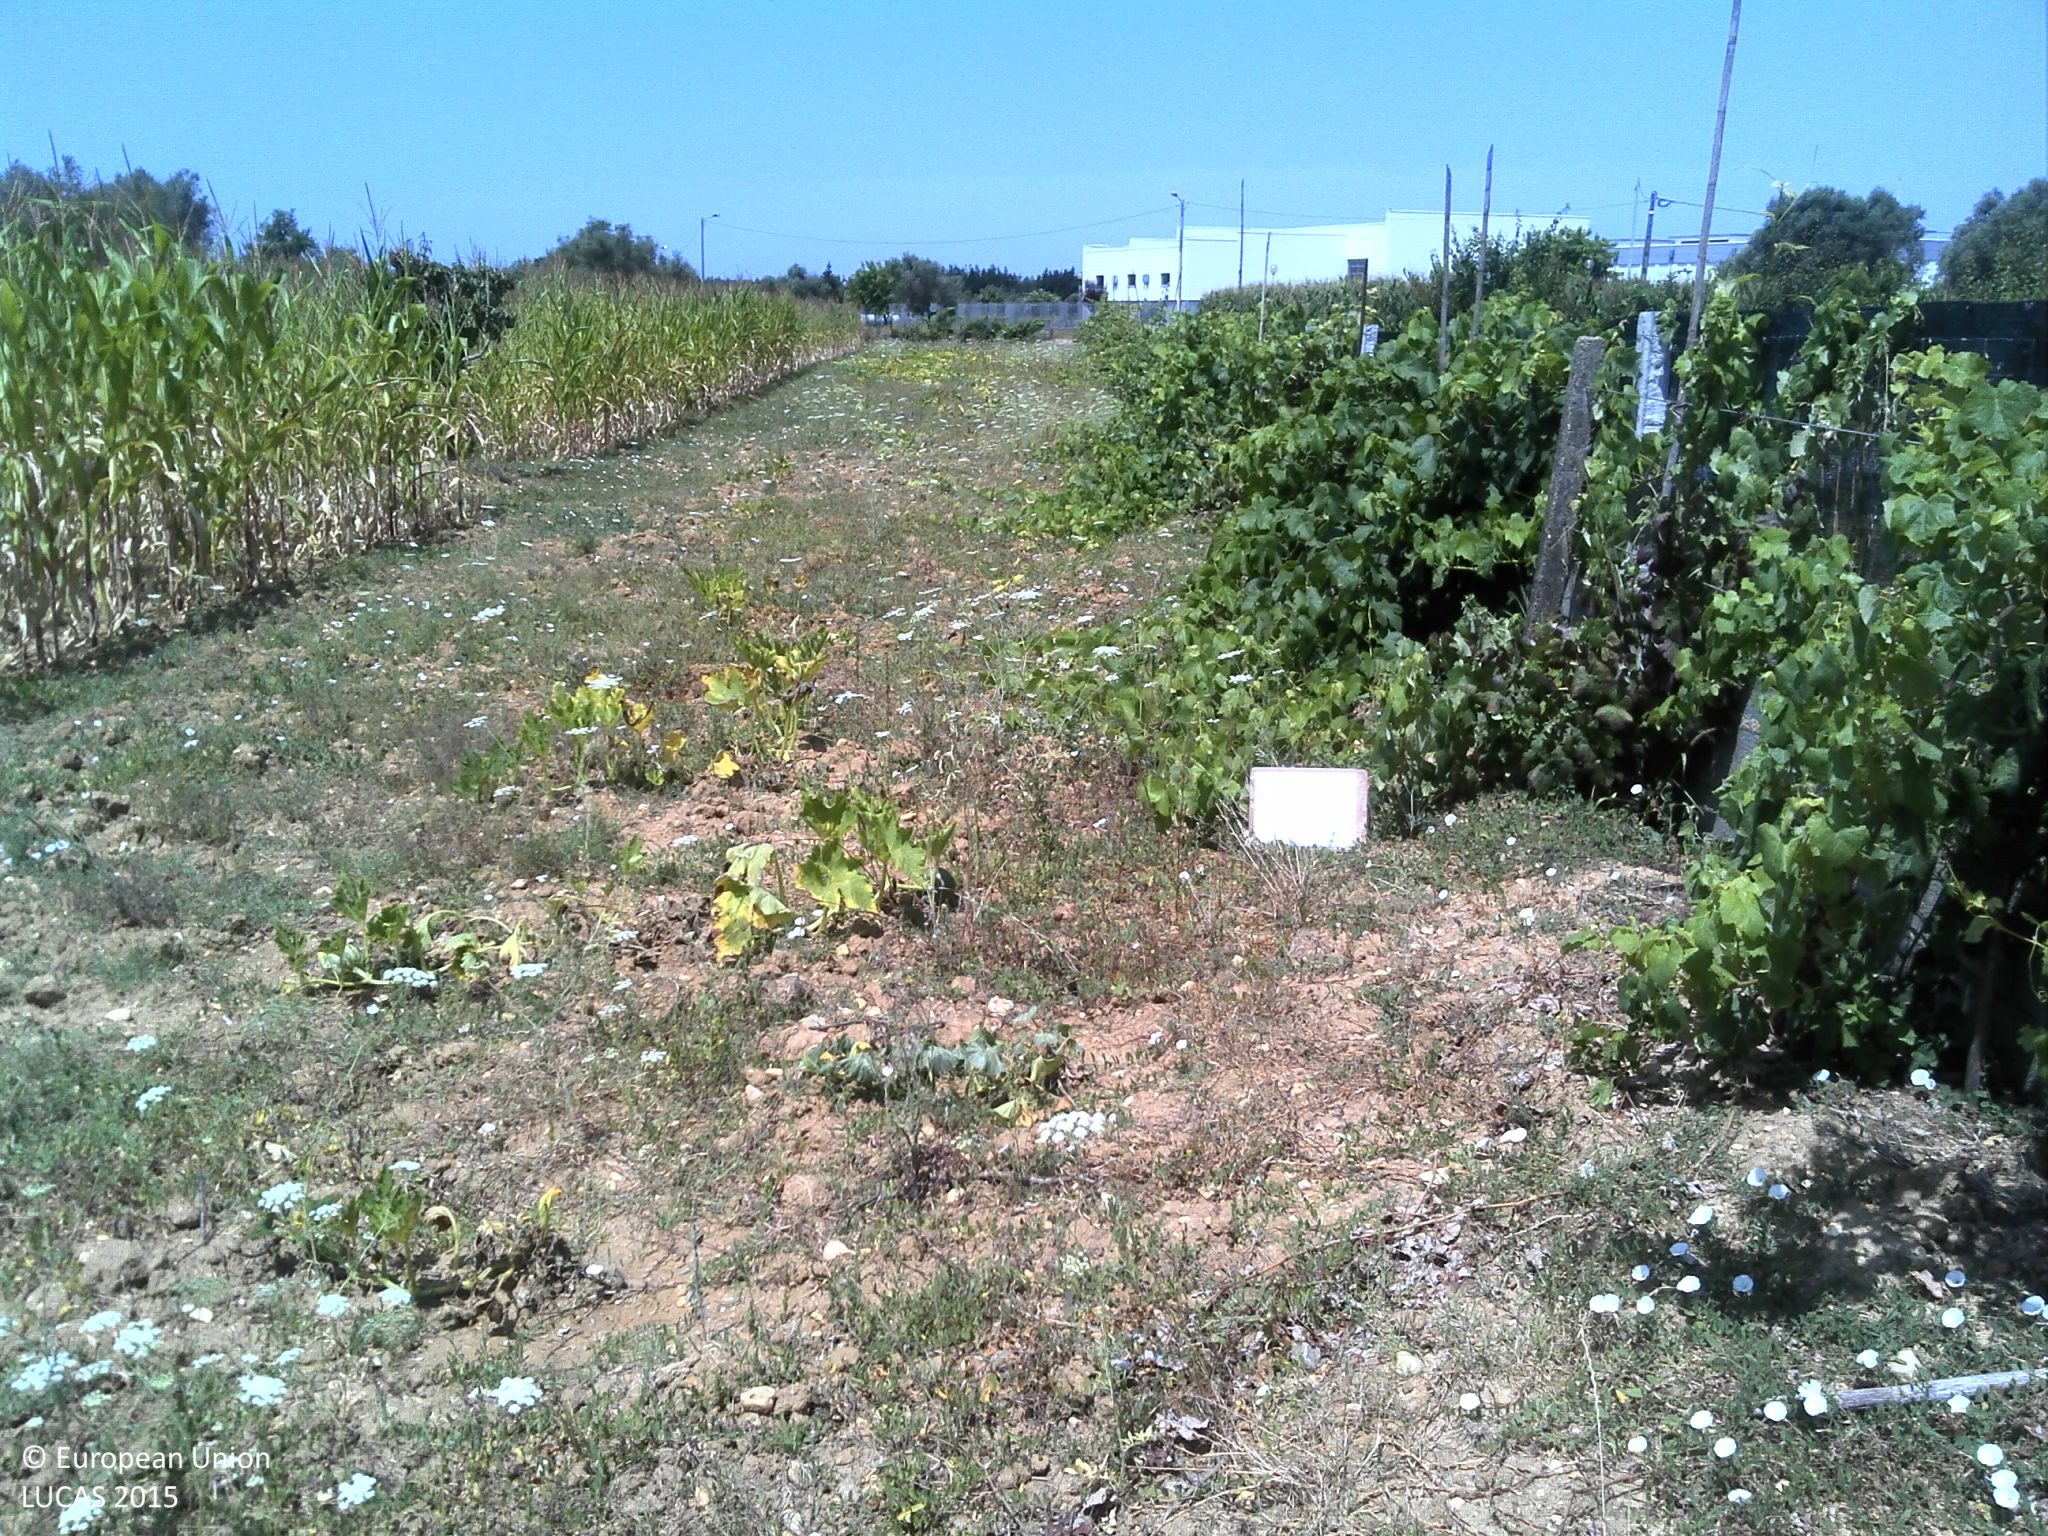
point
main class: Cropland
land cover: Other fresh vegetables
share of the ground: < 10 %
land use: Agriculture (excluding fallow land and kitchen gardens)
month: July
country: PT
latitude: 40.1765
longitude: -8.5835
